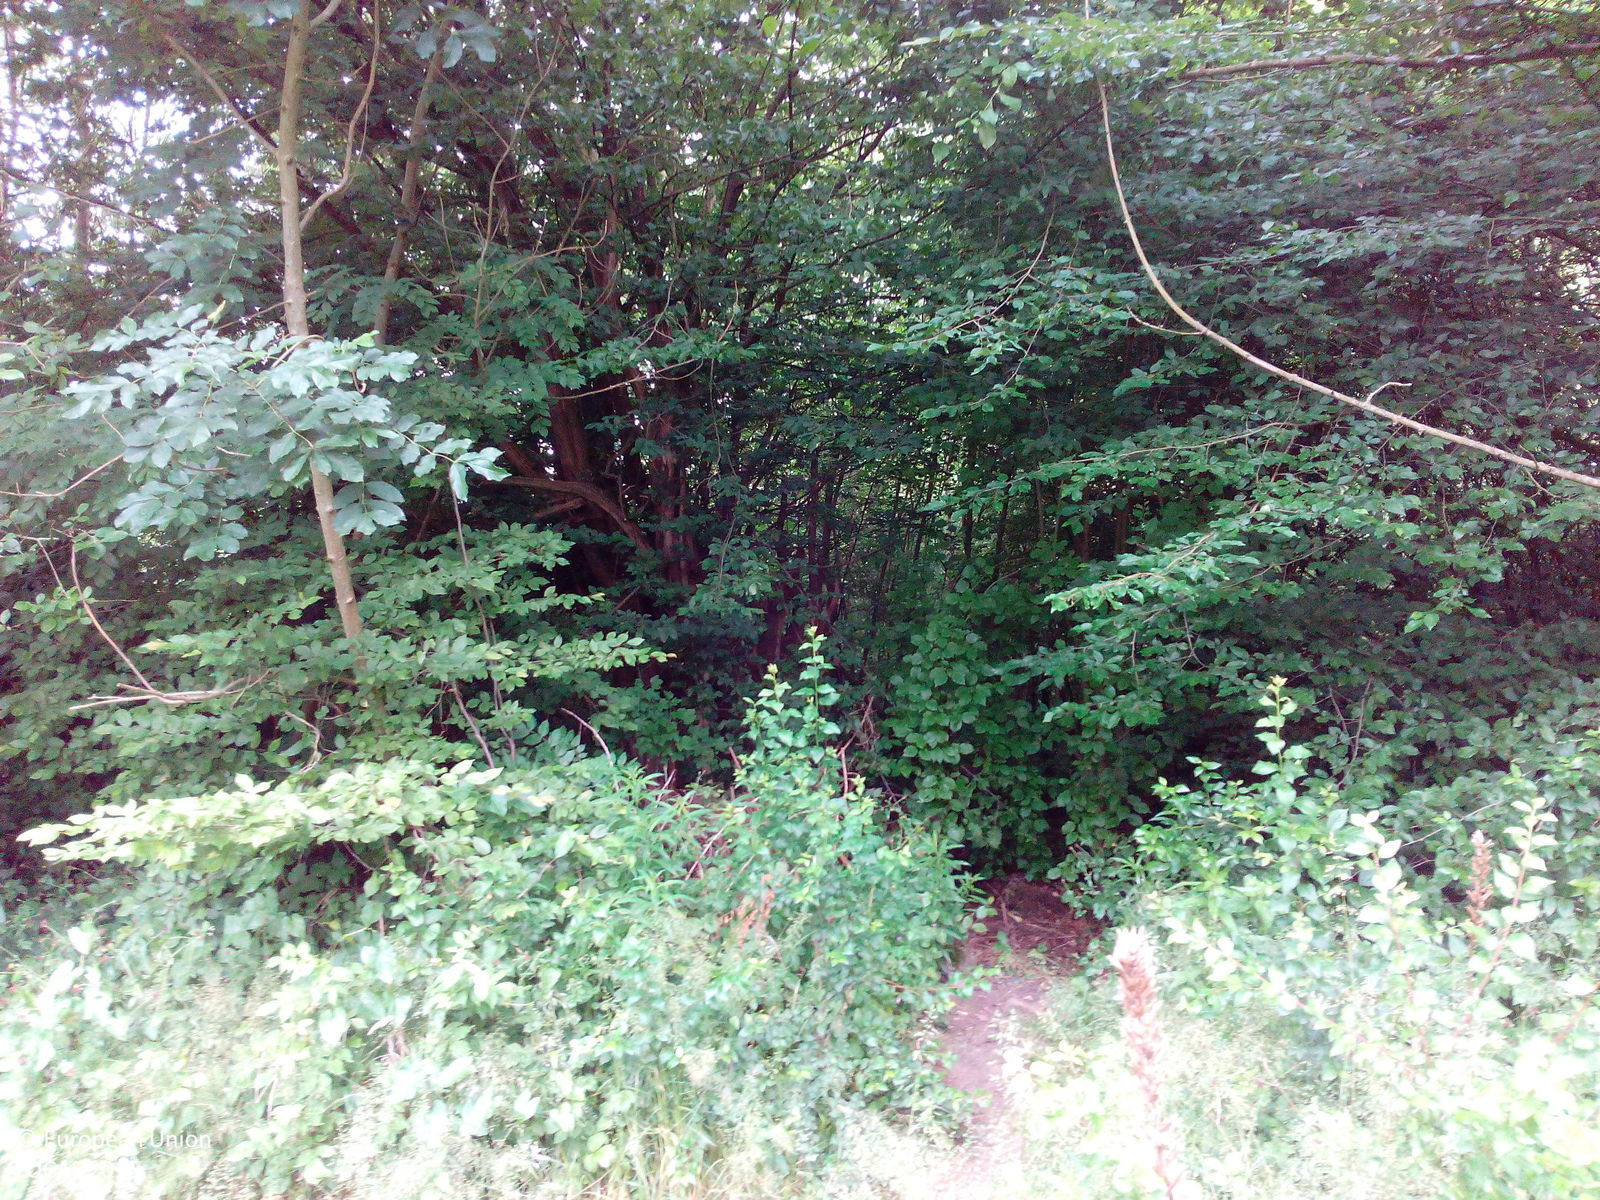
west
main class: Woodland
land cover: Broadleaved woodland
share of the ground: 50 - 75 %
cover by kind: broadleaved forest trees 70 %, herbaceous plants 30 %
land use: Residential
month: June
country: DE
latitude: 51.6579
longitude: 9.6387
